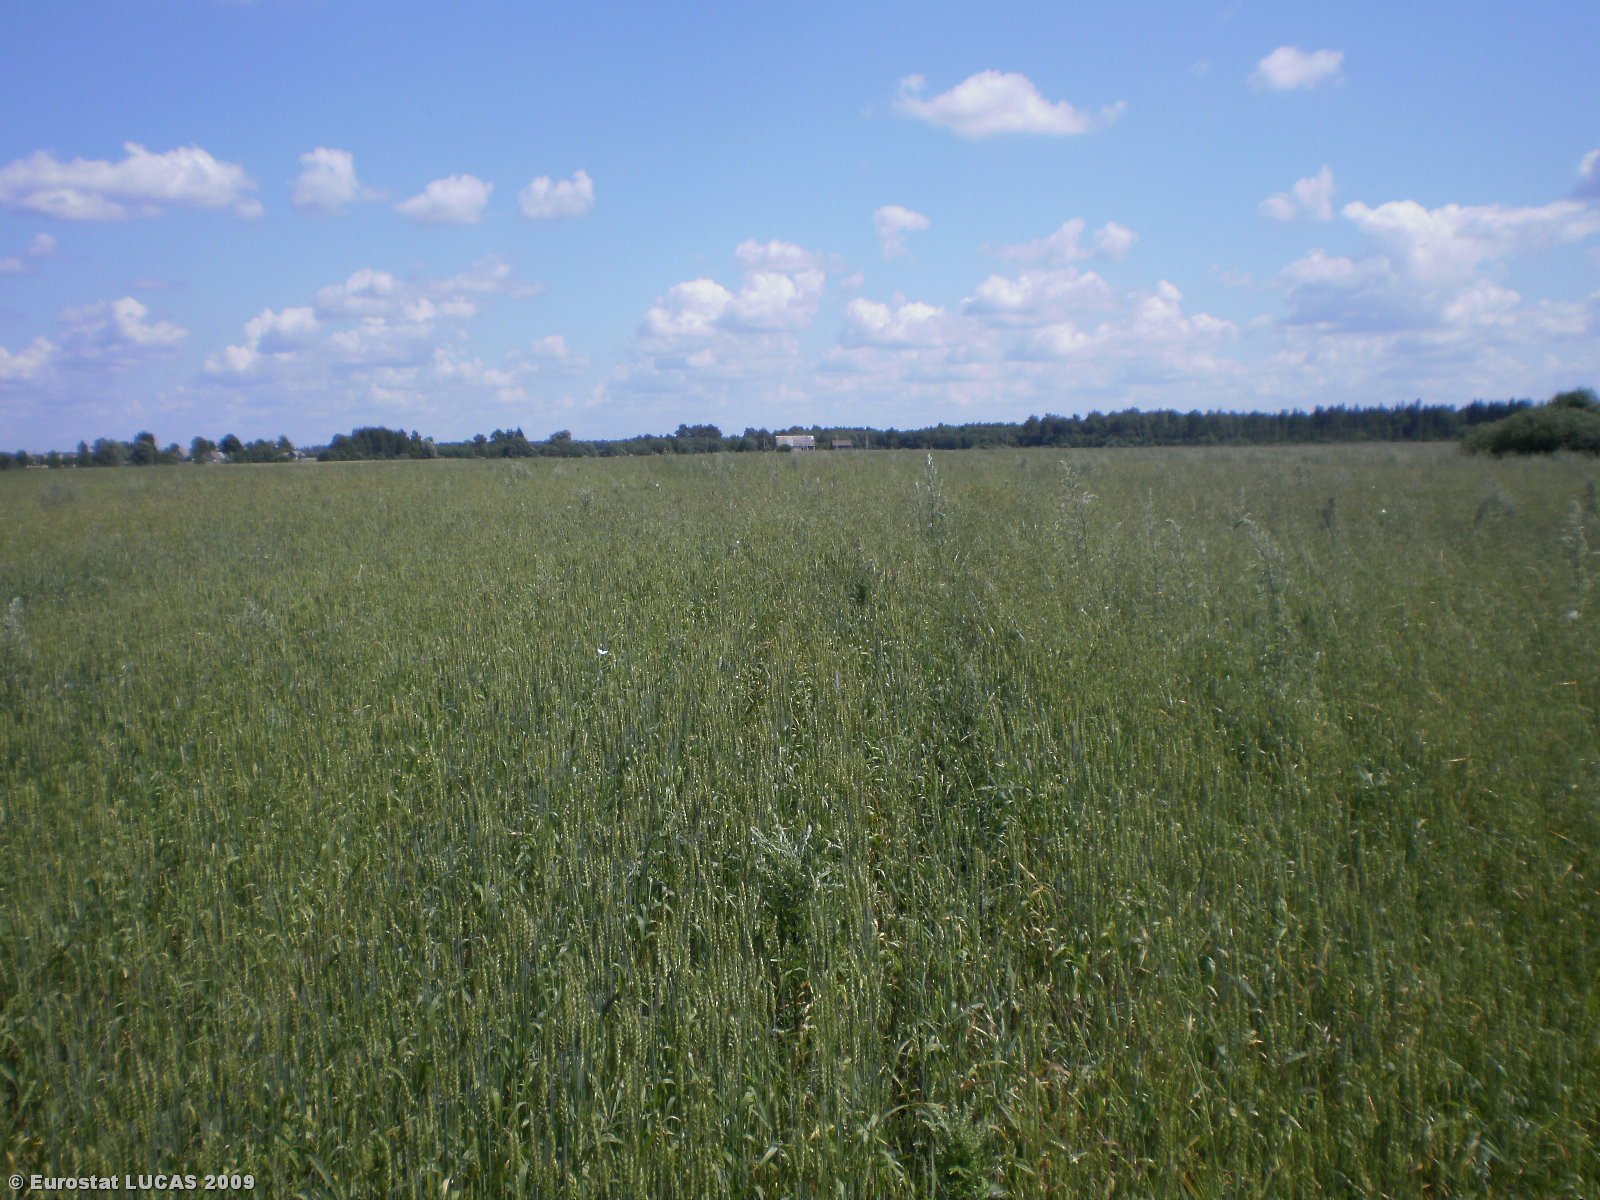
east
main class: Cropland
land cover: Common wheat
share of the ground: > 75 %
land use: Agriculture (excluding fallow land and kitchen gardens)
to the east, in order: Common wheat
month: July
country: LT
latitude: 56.1811
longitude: 24.9783
